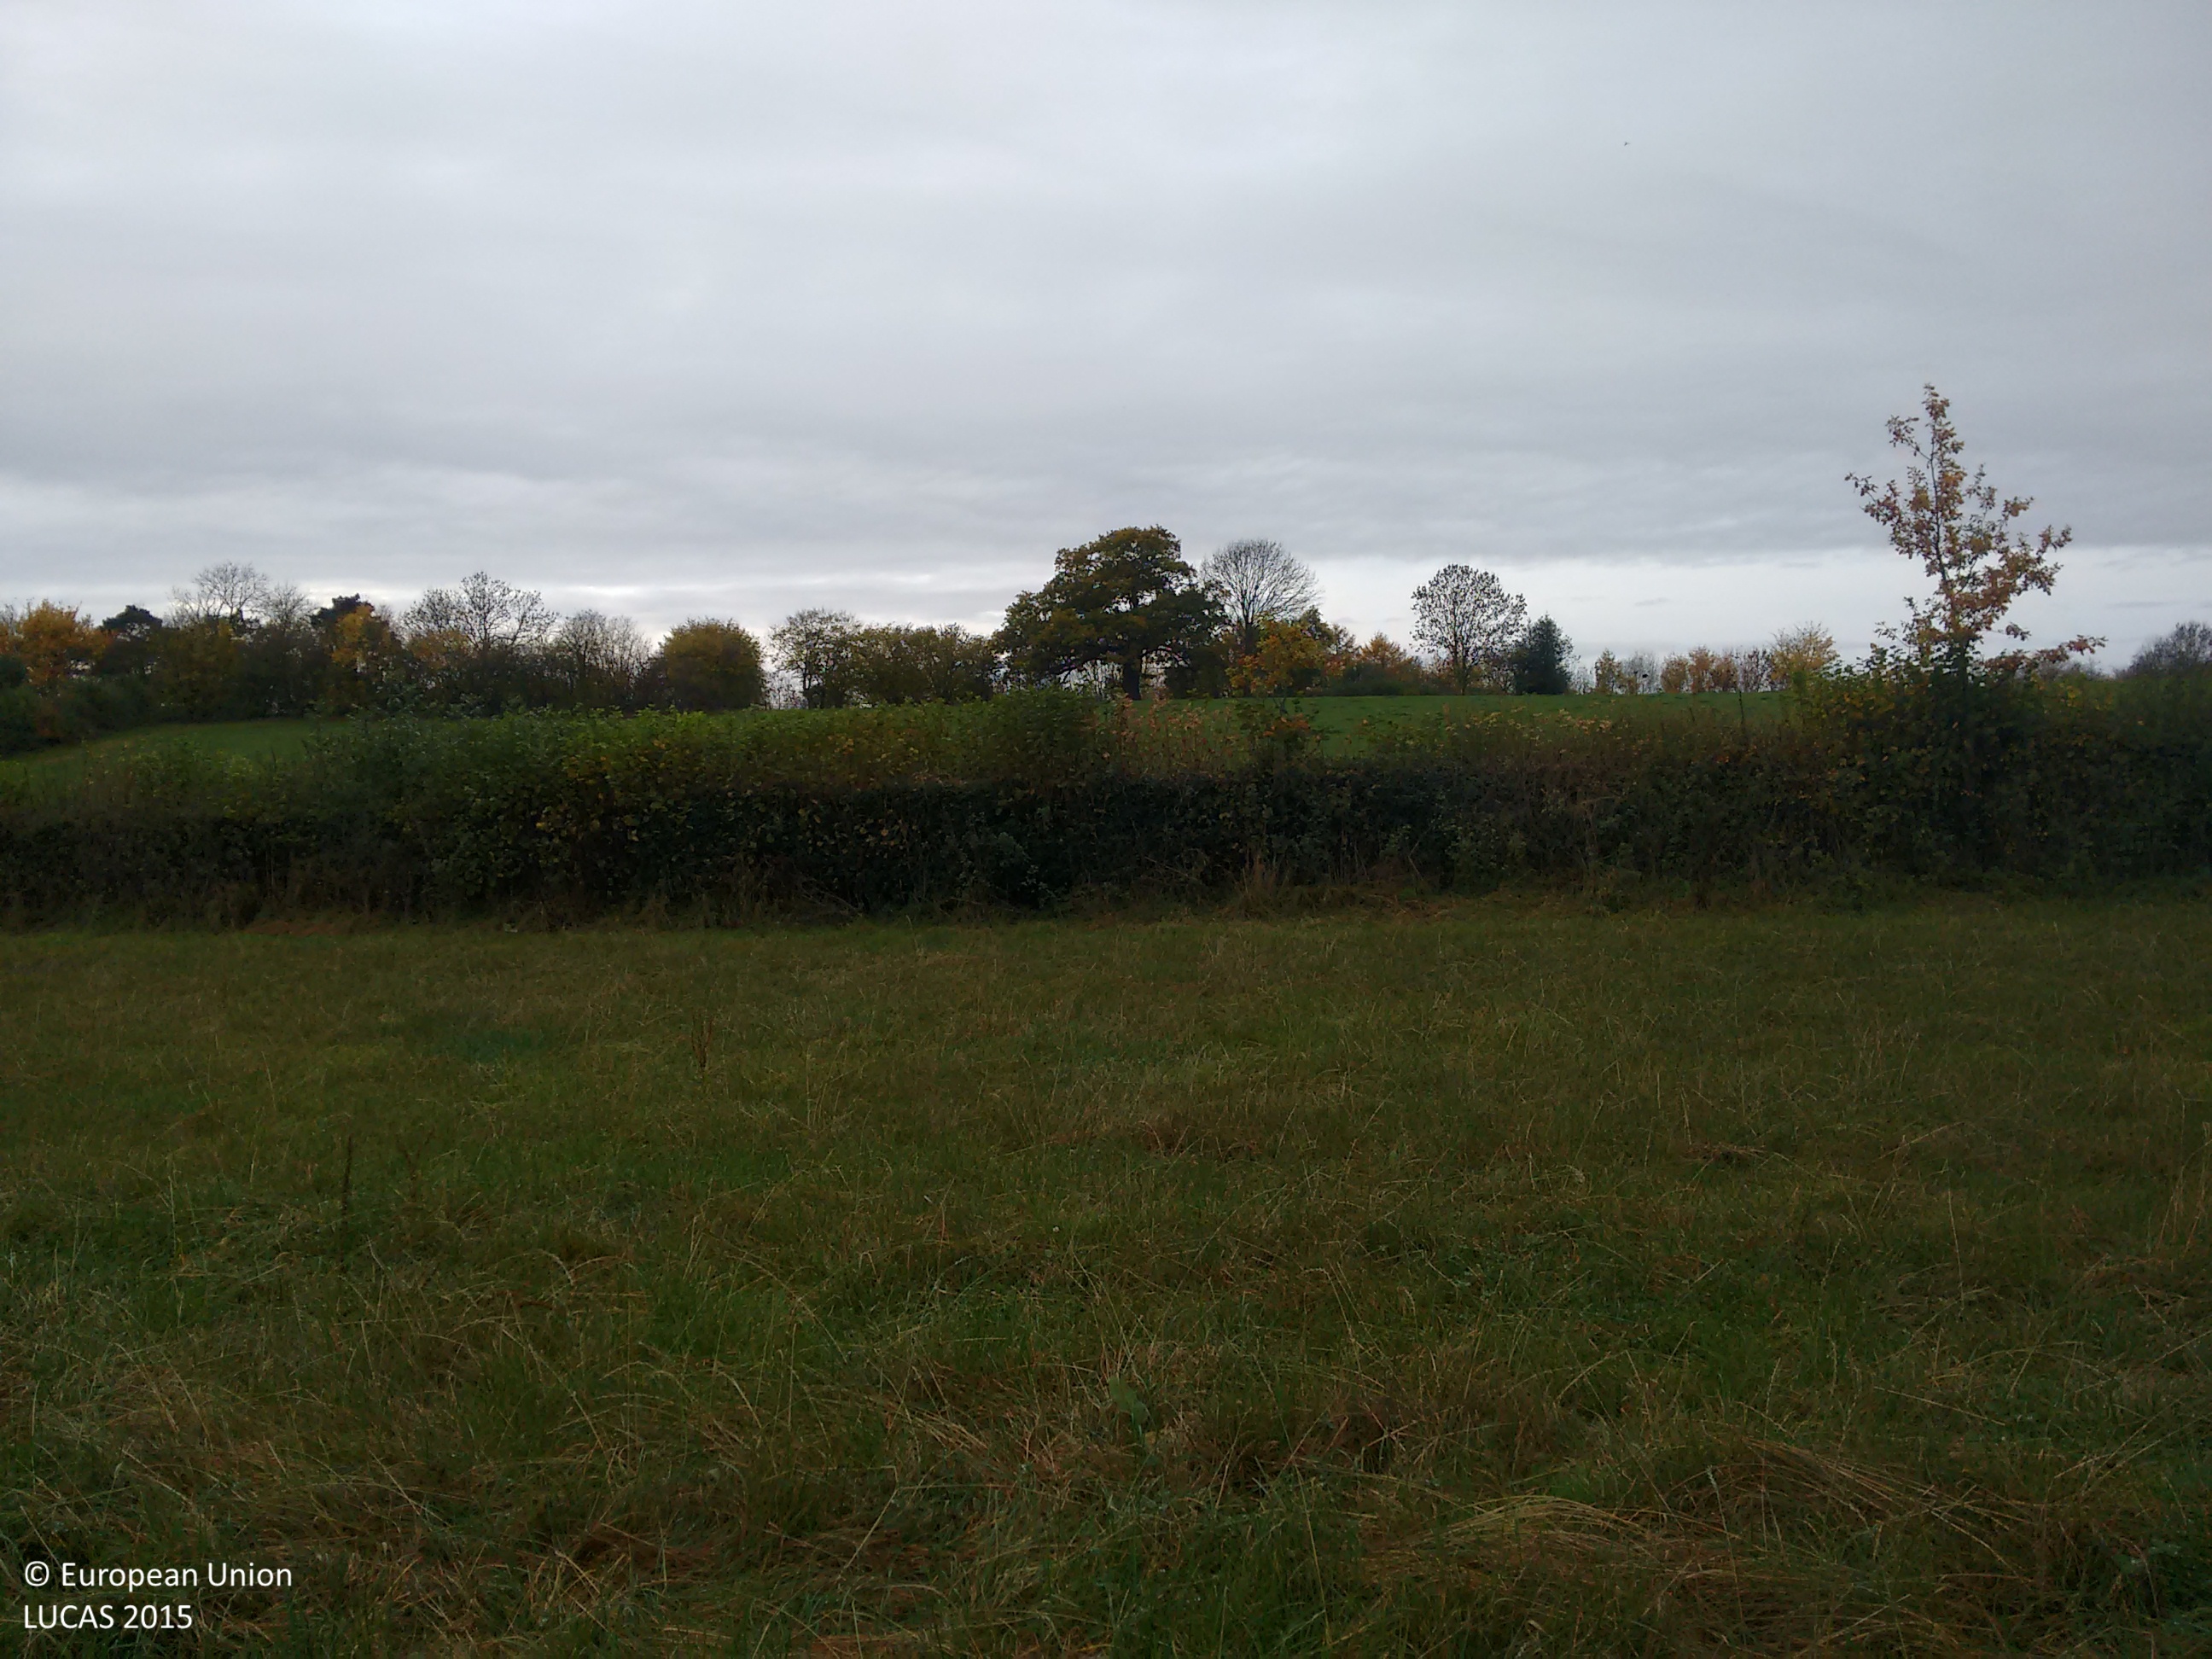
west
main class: Grassland
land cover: Grassland without tree/shrub cover
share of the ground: > 75 %
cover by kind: herbaceous plants 100 %
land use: Agriculture (excluding fallow land and kitchen gardens)
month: October
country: GB
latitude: 52.3505
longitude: -2.5011
